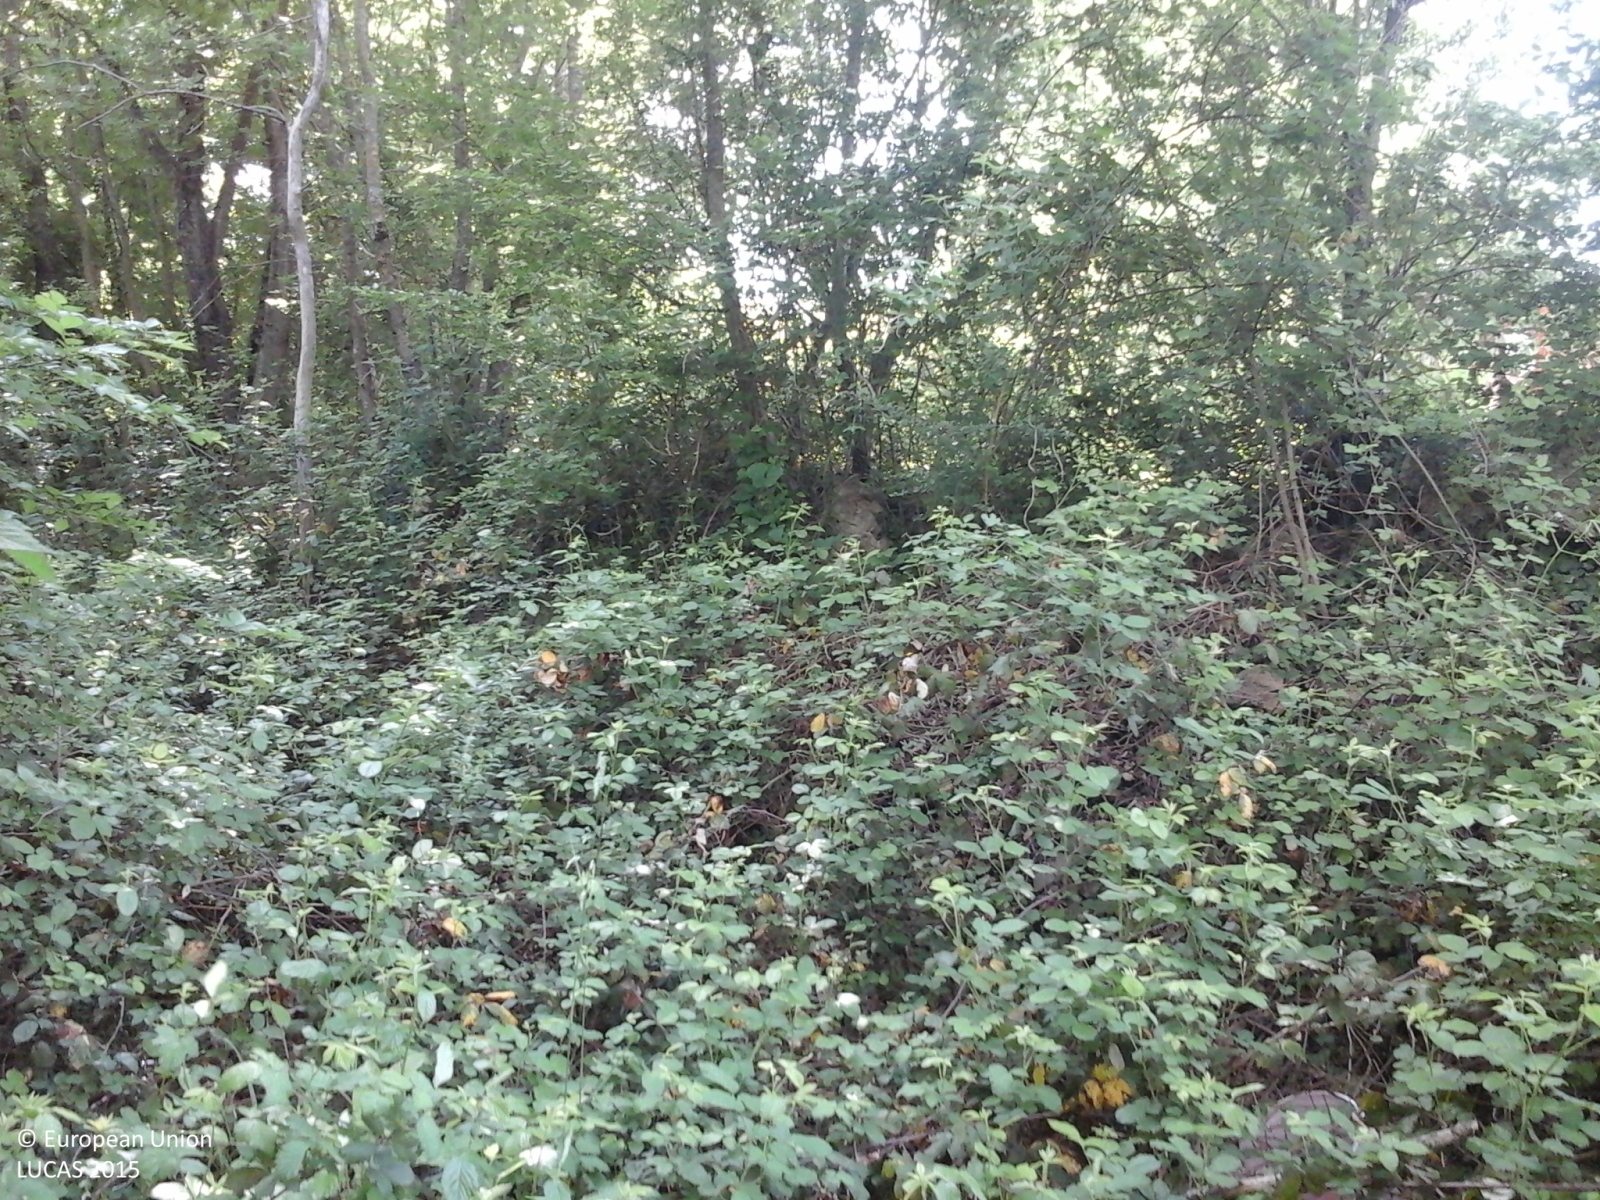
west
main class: Woodland
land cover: Broadleaved woodland
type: thermophilous deciduous forest
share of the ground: > 75 %
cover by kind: broadleaved forest trees 100 %
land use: Forestry
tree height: > 5 m
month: May
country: IT
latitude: 41.3525
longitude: 14.6564
